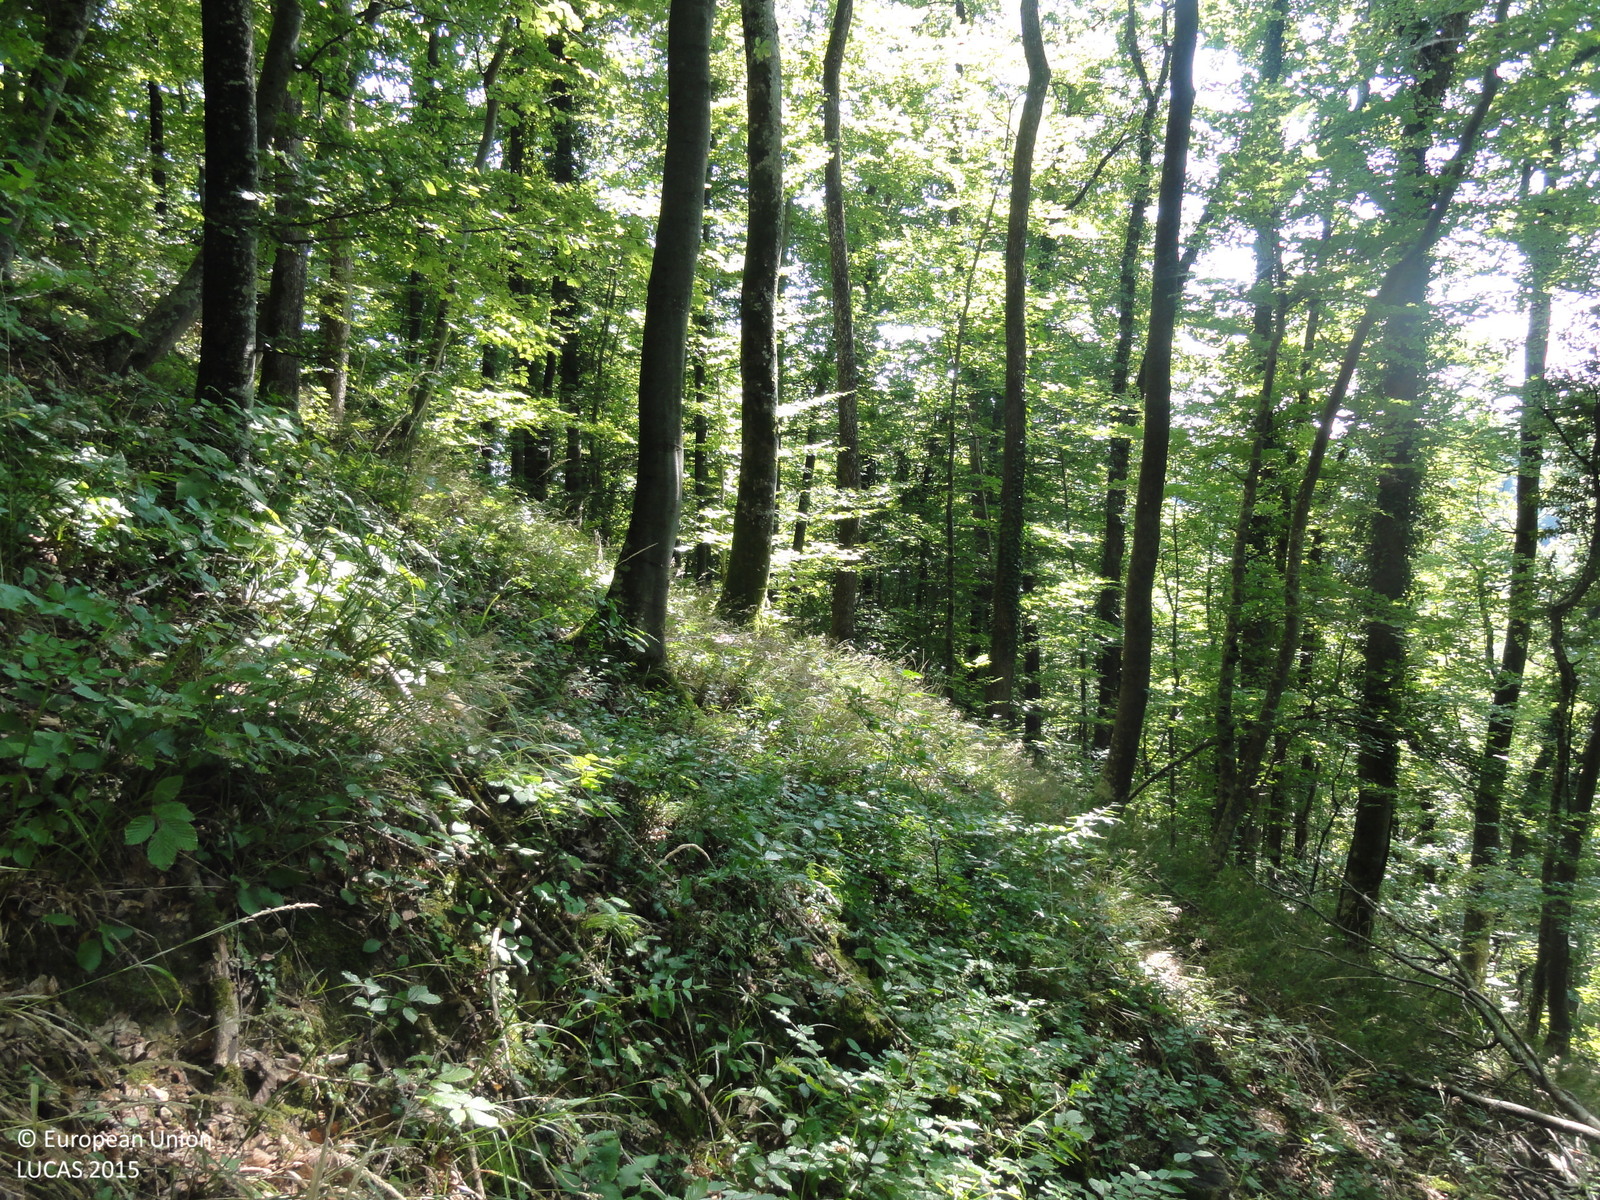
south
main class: Woodland
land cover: Broadleaved woodland
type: beech forest
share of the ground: > 75 %
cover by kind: broadleaved forest trees 100 %
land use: Forestry
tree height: > 5 m
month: August
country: SI
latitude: 45.9796
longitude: 15.0437
